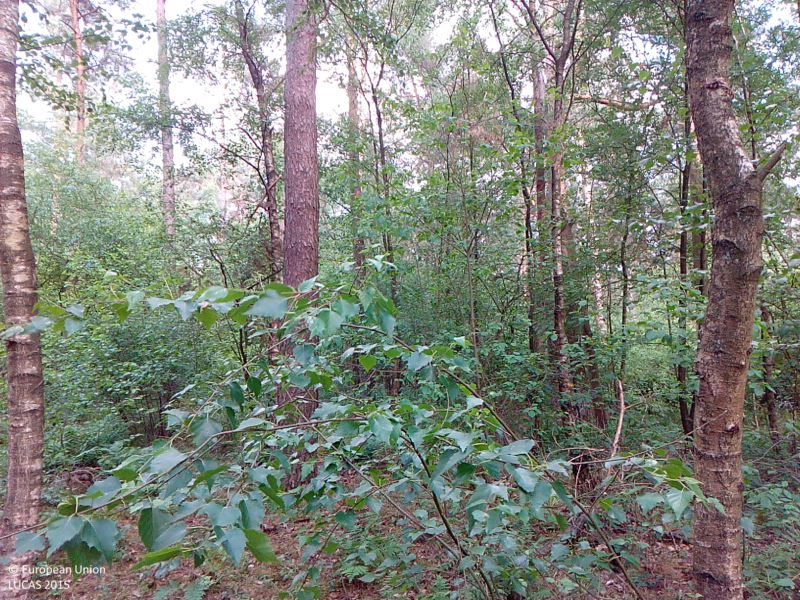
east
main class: Woodland
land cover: Pine dominated mixed woodland
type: hemiboreal forest and nemoral coniferous forest and mixed broadleaved-coniferous forest
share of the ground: > 75 %
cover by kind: coniferous forest trees 40 %, broadleaved forest trees 35 %, shrubs 15 %, herbaceous plants 10 %
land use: Forestry
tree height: > 5 m
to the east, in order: Pine dominated mixed woodland; Tracks; Pine dominated mixed woodland
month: June
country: DE
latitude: 52.4940
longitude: 7.4523
